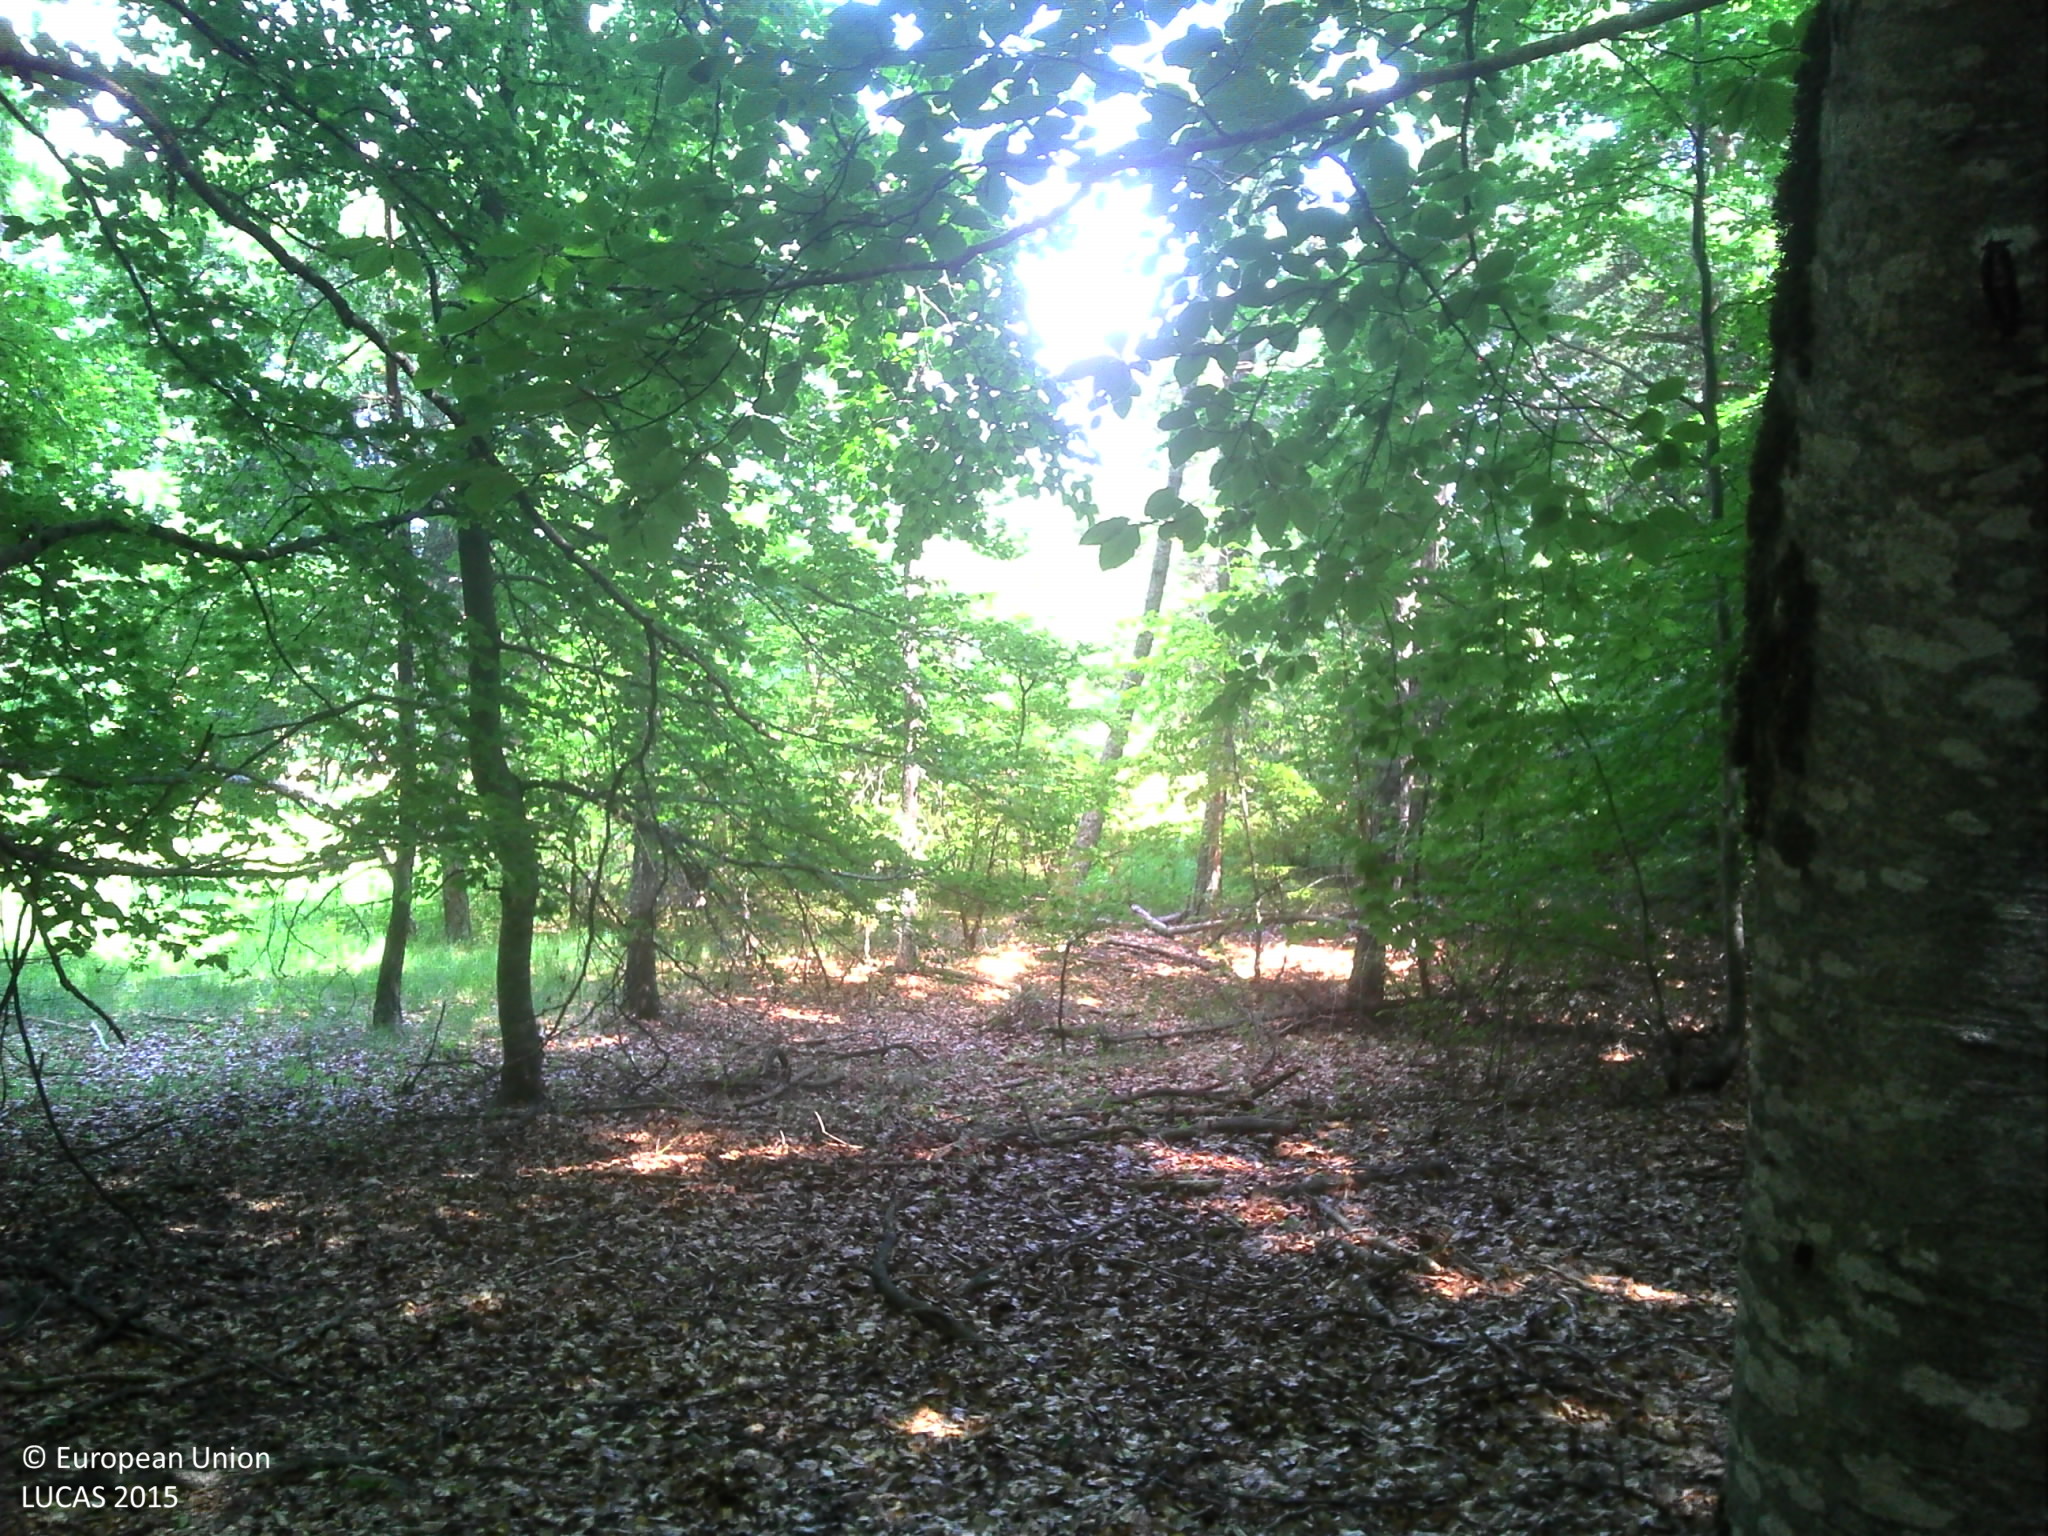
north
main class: Woodland
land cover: Broadleaved woodland
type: beech forest
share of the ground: > 75 %
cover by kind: broadleaved forest trees 85 %, shrubs 5 %, herbaceous plants 5 %, lichens and mosses 5 %
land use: Forestry
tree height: > 5 m
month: July
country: FR
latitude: 44.4291
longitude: 6.3010
